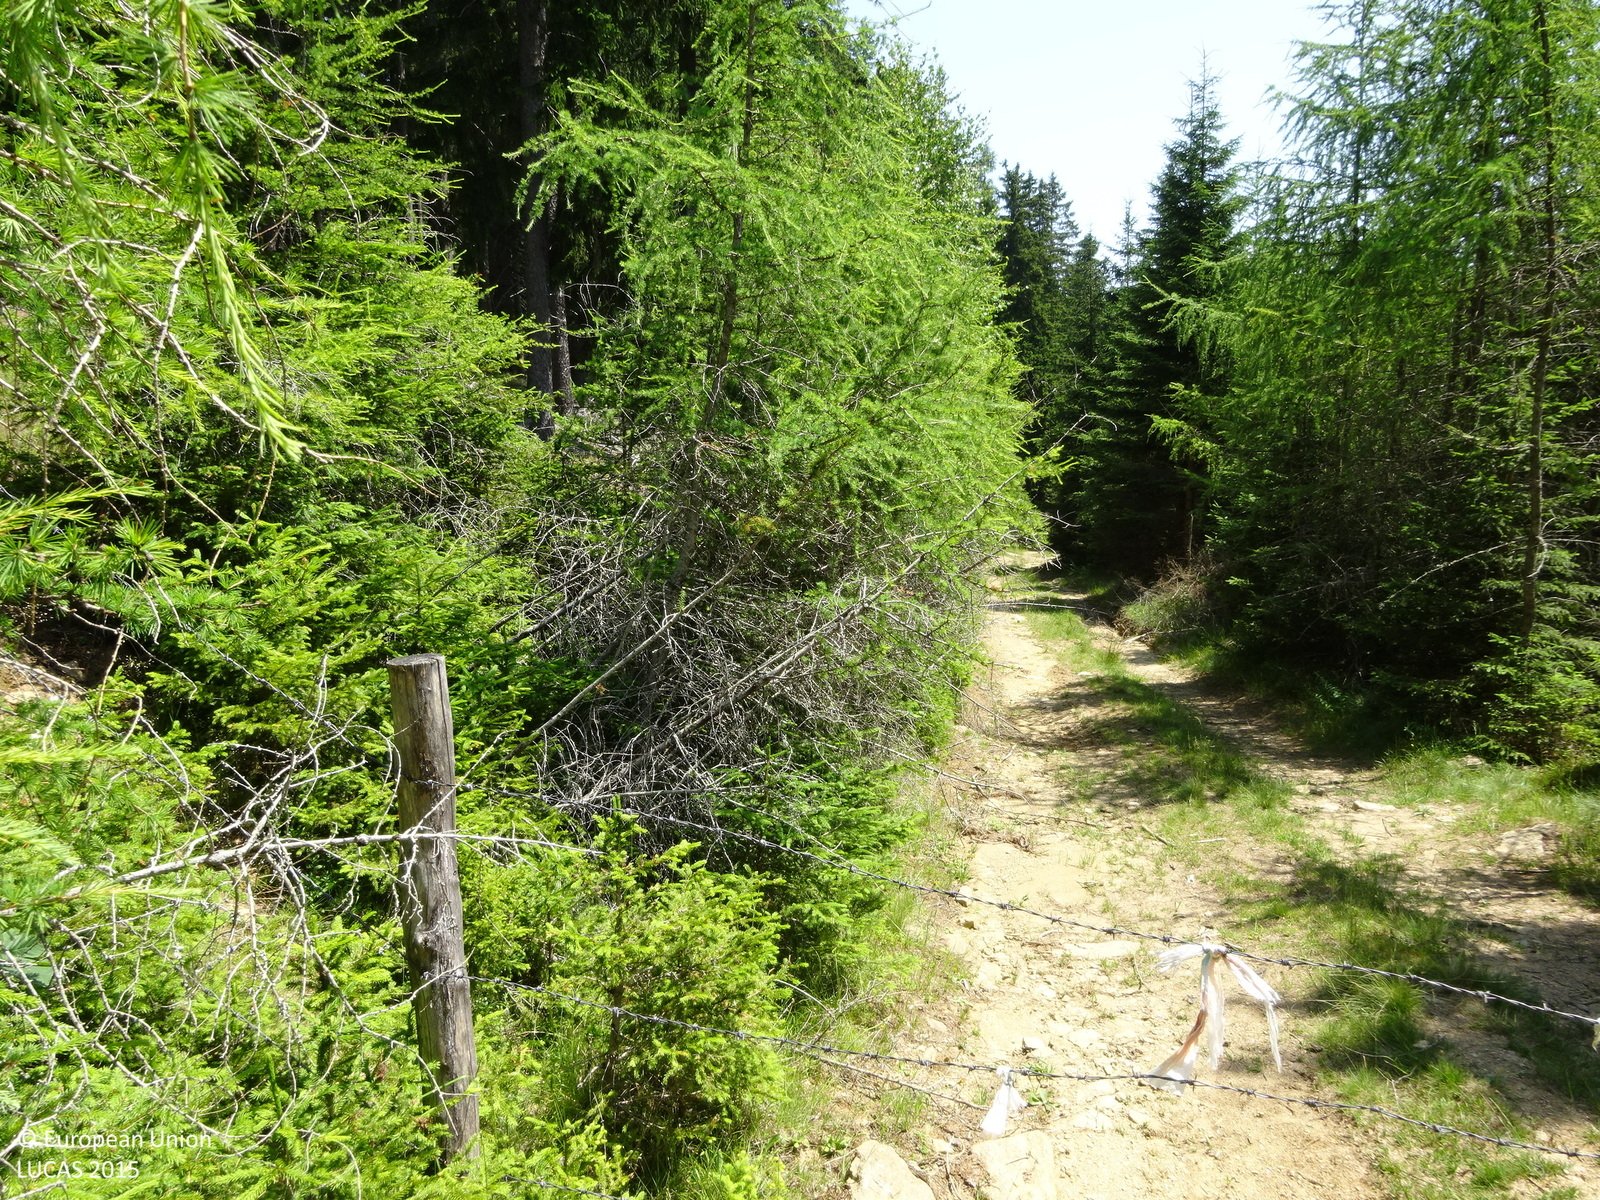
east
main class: Woodland
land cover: Other coniferous woodland
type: alpine coniferous forest
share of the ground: > 75 %
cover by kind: coniferous forest trees 75 %, herbaceous plants 25 %
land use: Forestry
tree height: > 5 m
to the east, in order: Tracks; Other coniferous woodland; Fences; Other coniferous woodland; Spruce dominated coniferous woodland; Grass margins; Fences; Tracks; Spruce dominated coniferous woodland
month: July
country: AT
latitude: 47.0659
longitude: 14.9631
